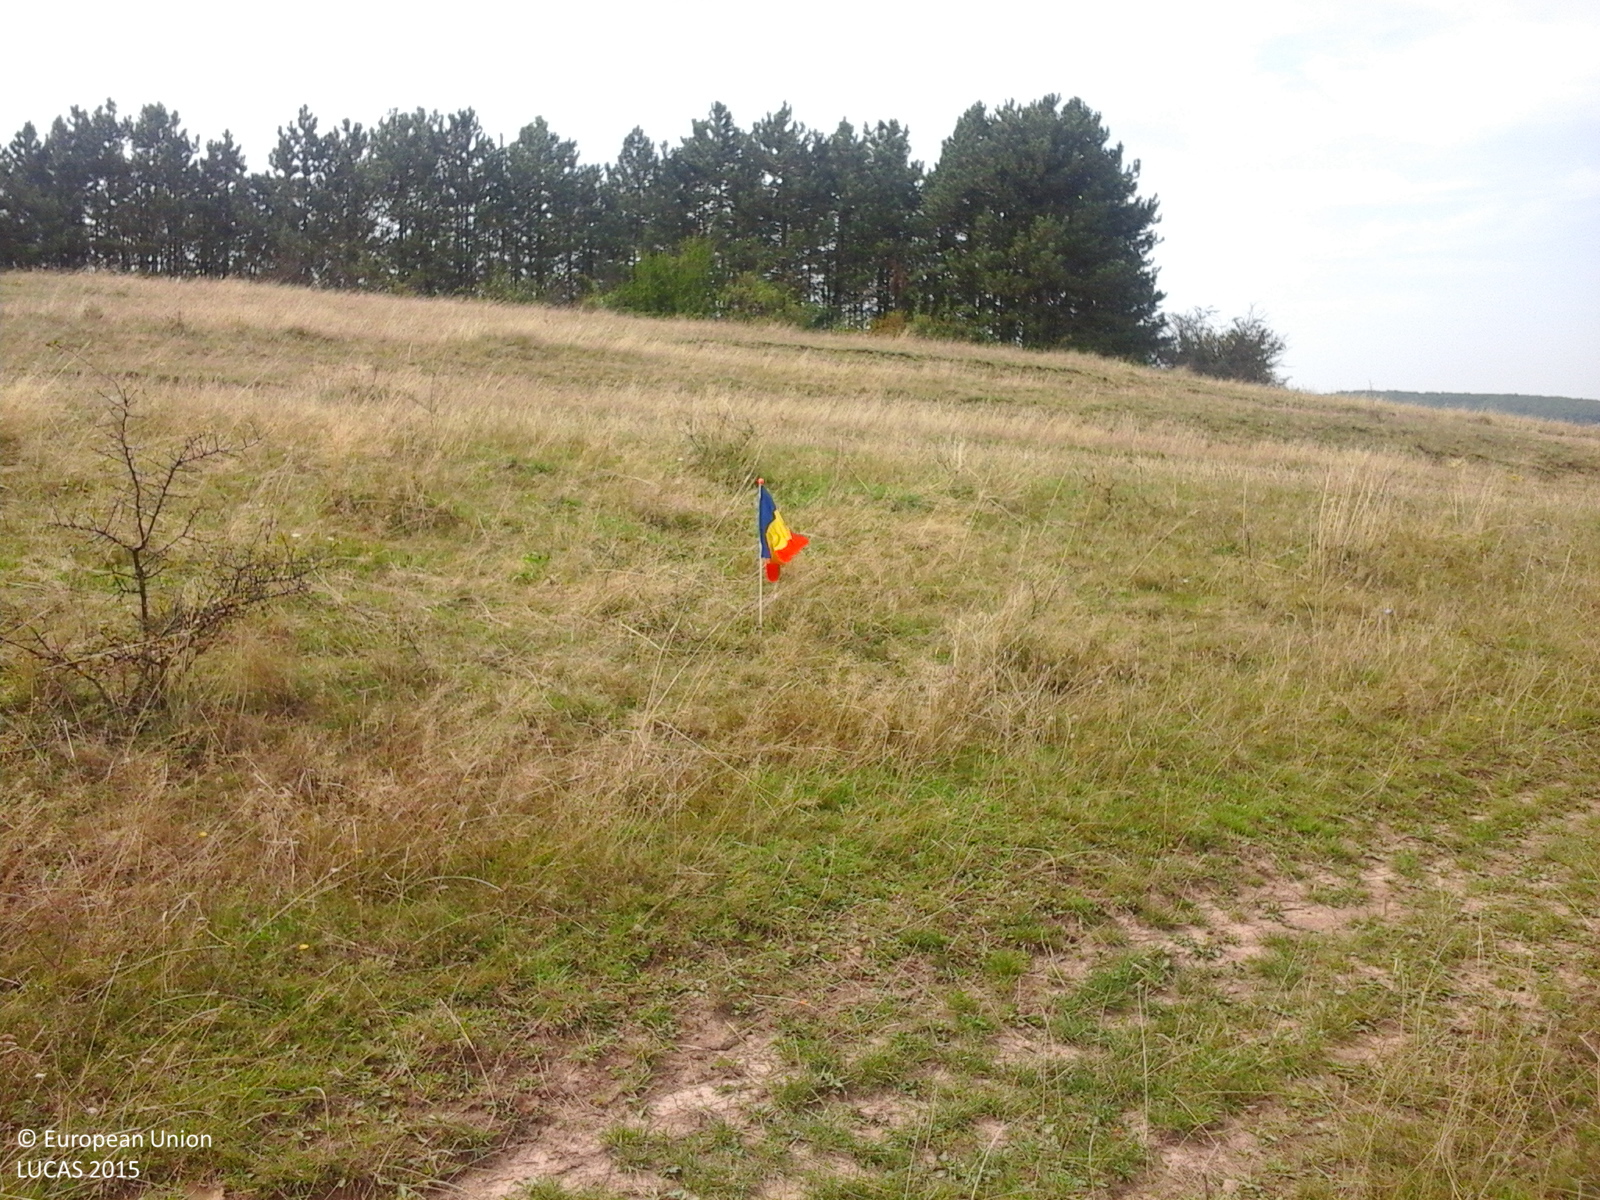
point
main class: Grassland
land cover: Grassland with sparse tree/shrub cover
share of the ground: > 75 %
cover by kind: herbaceous plants 85 %, shrubs 10 %, broadleaved forest trees 5 %
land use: Fallow land
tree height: < 5 m
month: September
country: RO
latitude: 47.1589
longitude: 23.7278
